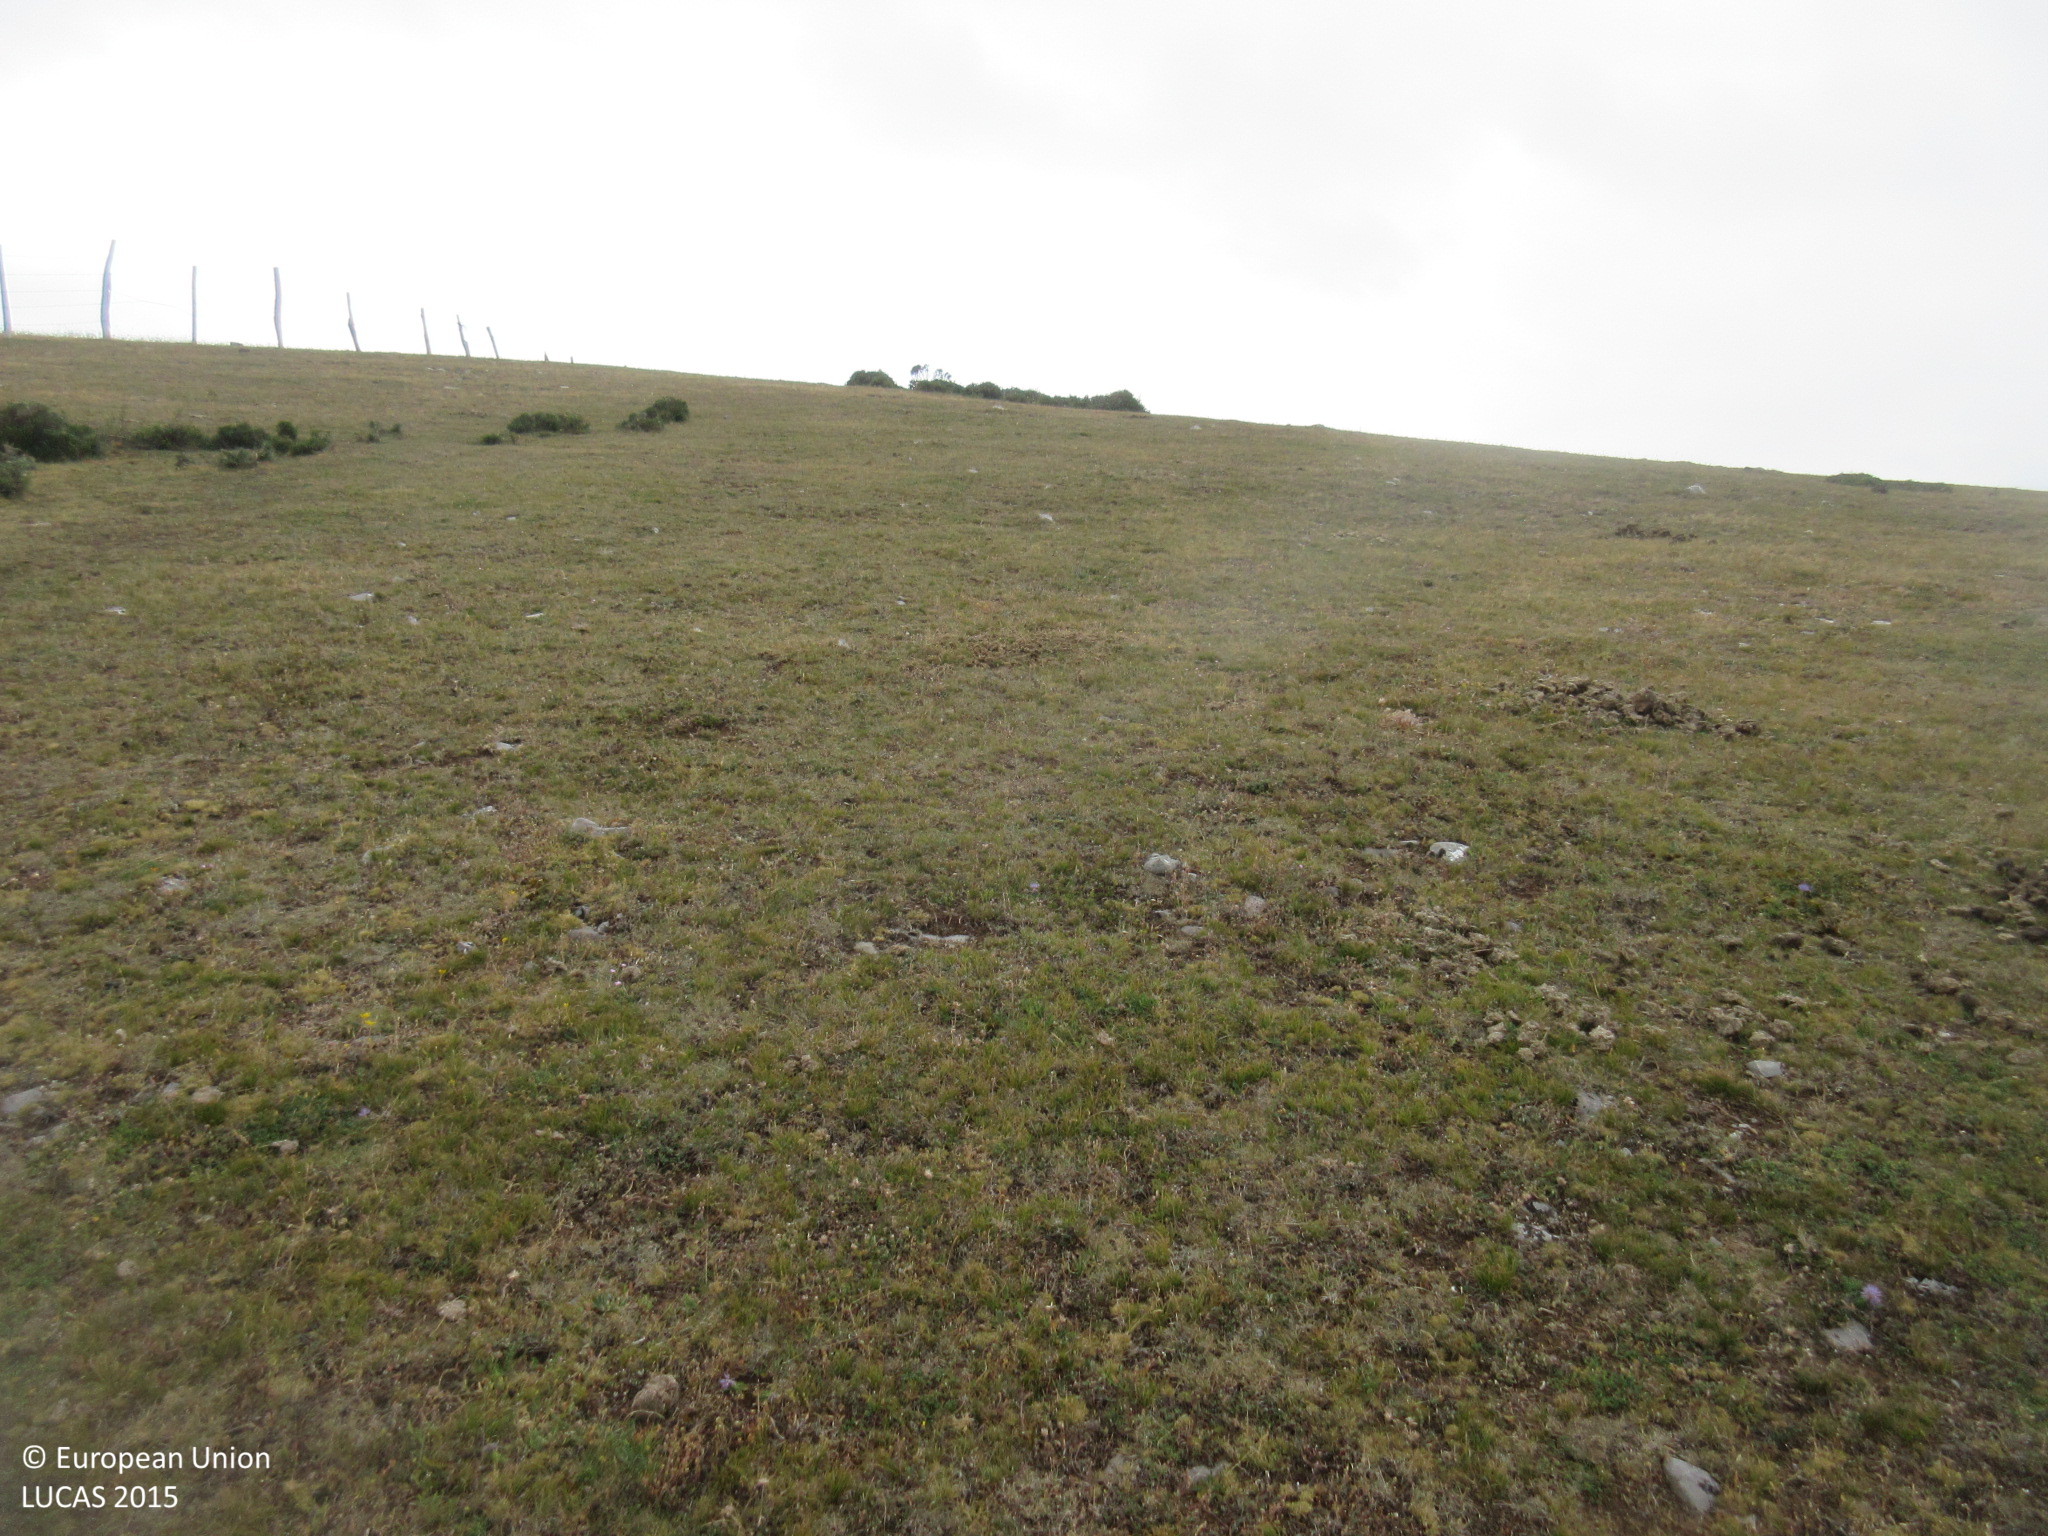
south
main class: Grassland
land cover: Grassland without tree/shrub cover
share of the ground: > 75 %
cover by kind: herbaceous plants 95 %, shrubs 5 %
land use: Agriculture (excluding fallow land and kitchen gardens)
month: July
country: ES
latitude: 43.0241
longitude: -4.1755
